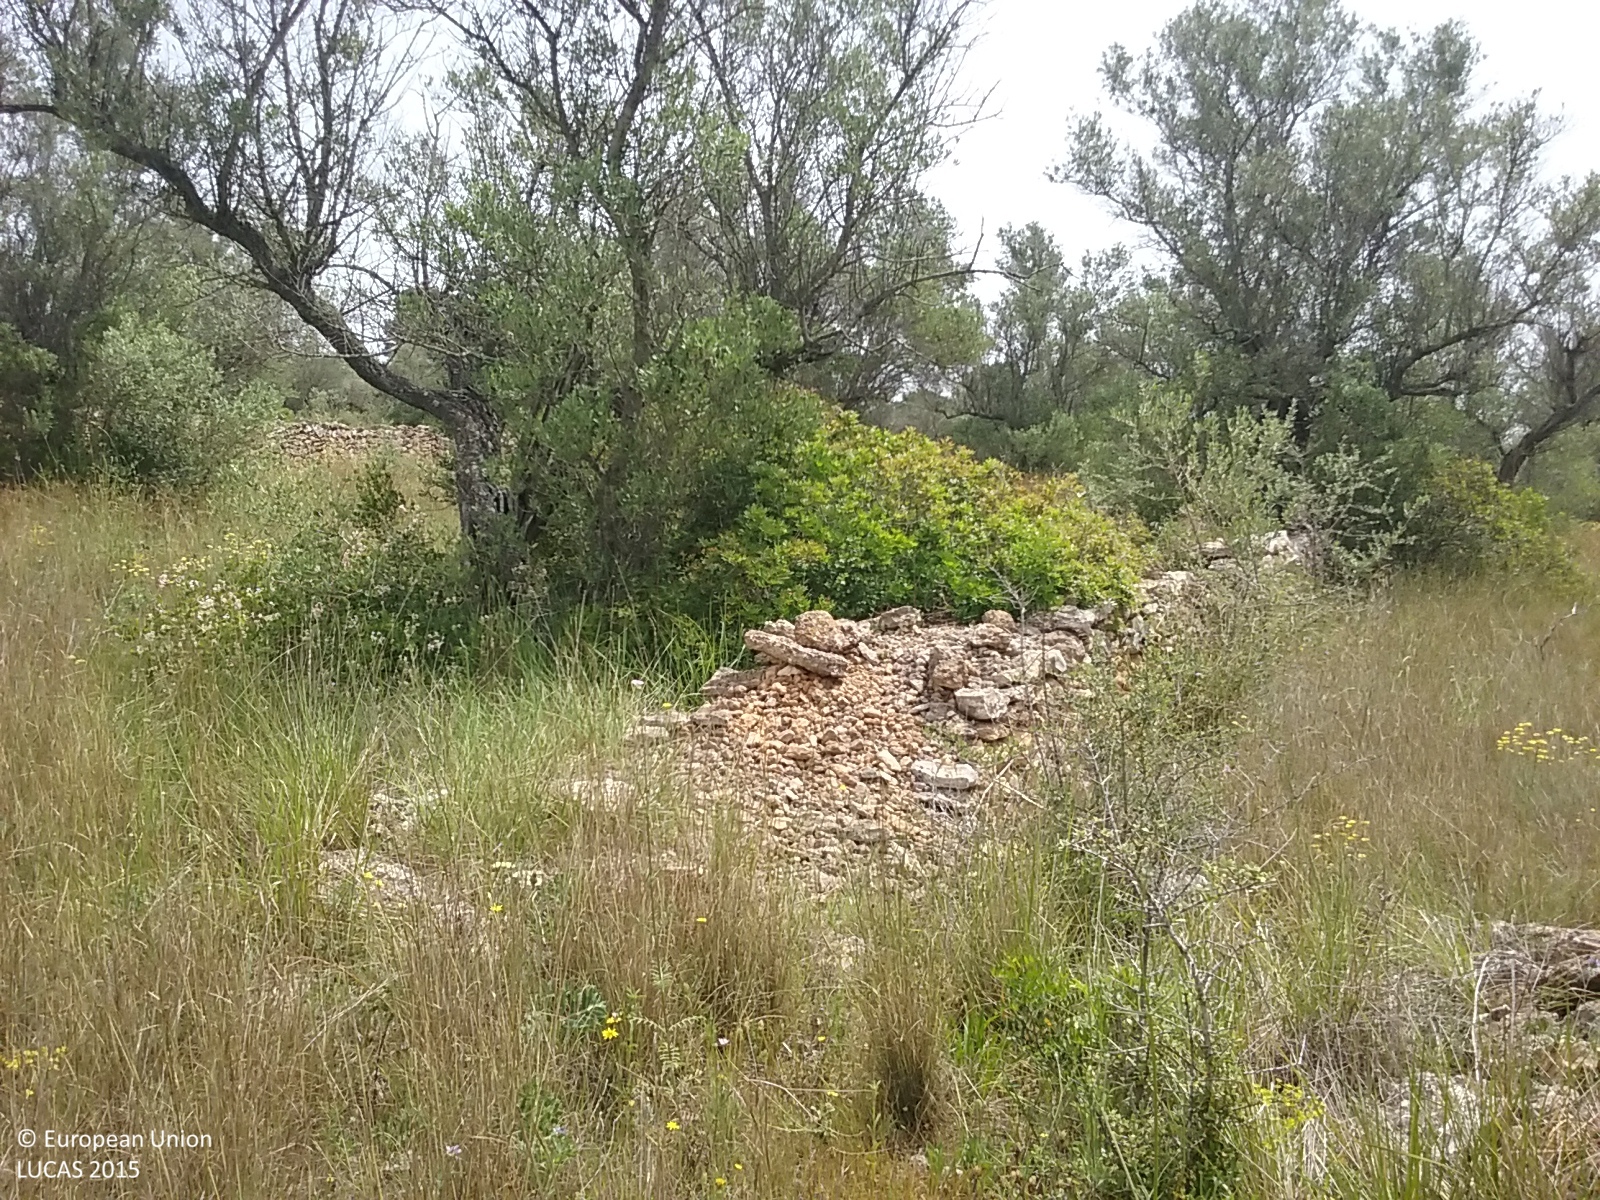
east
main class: Cropland
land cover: Olive groves
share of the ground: 25 - 50 %
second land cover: Grassland without tree/shrub cover
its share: > 75 %
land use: Abandoned areas
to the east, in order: Olive groves; Grassland without tree/shrub cover; Dry stone walls; Olive groves; Dry stone walls; Olive groves; Dry stone walls; Olive groves; Dry stone walls; Olive groves; Abandoned hedges; Dry stone walls; Olive groves; Dry stone walls; Olive groves; Dry stone walls; Olive groves; Dry stone walls; Groves; Dry stone walls; Olive groves; Dry stone walls; Olive groves
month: May
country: ES
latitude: 40.7974
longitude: 0.5954
